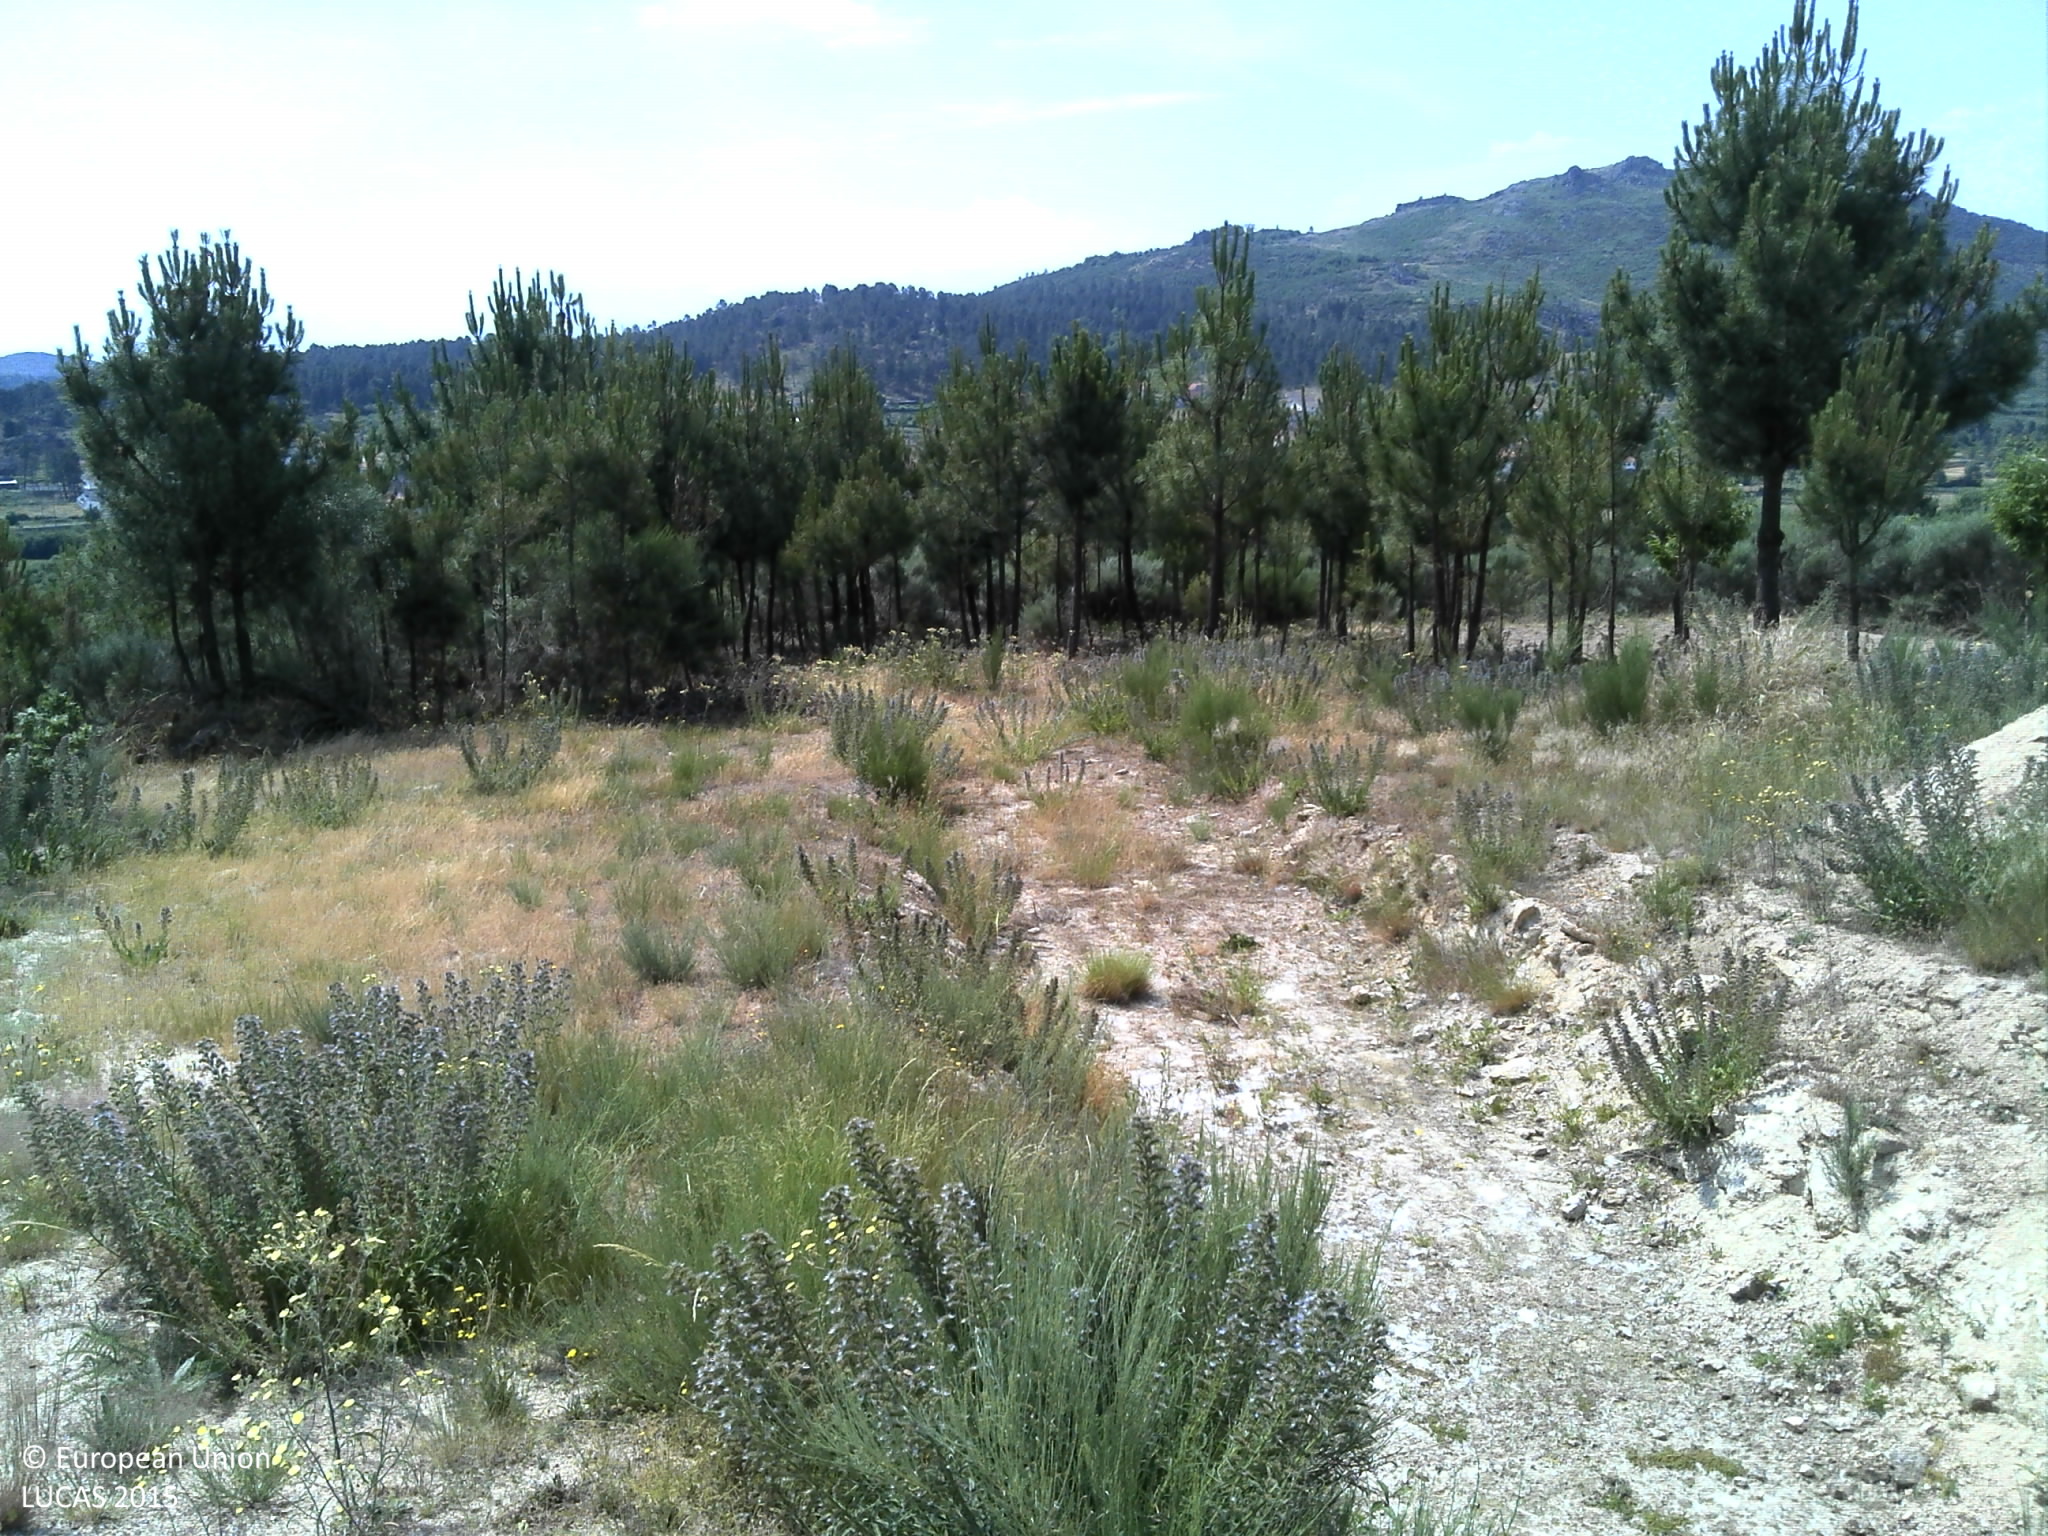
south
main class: Shrubland
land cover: Shrubland with sparse tree cover
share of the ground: 50 - 75 %
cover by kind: shrubs 70 %, unconsolidated bare surface 25 %, coniferous forest trees 5 %
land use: Semi-natural and natural areas not in use
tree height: > 5 m
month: June
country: PT
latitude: 41.4192
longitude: -7.5600
